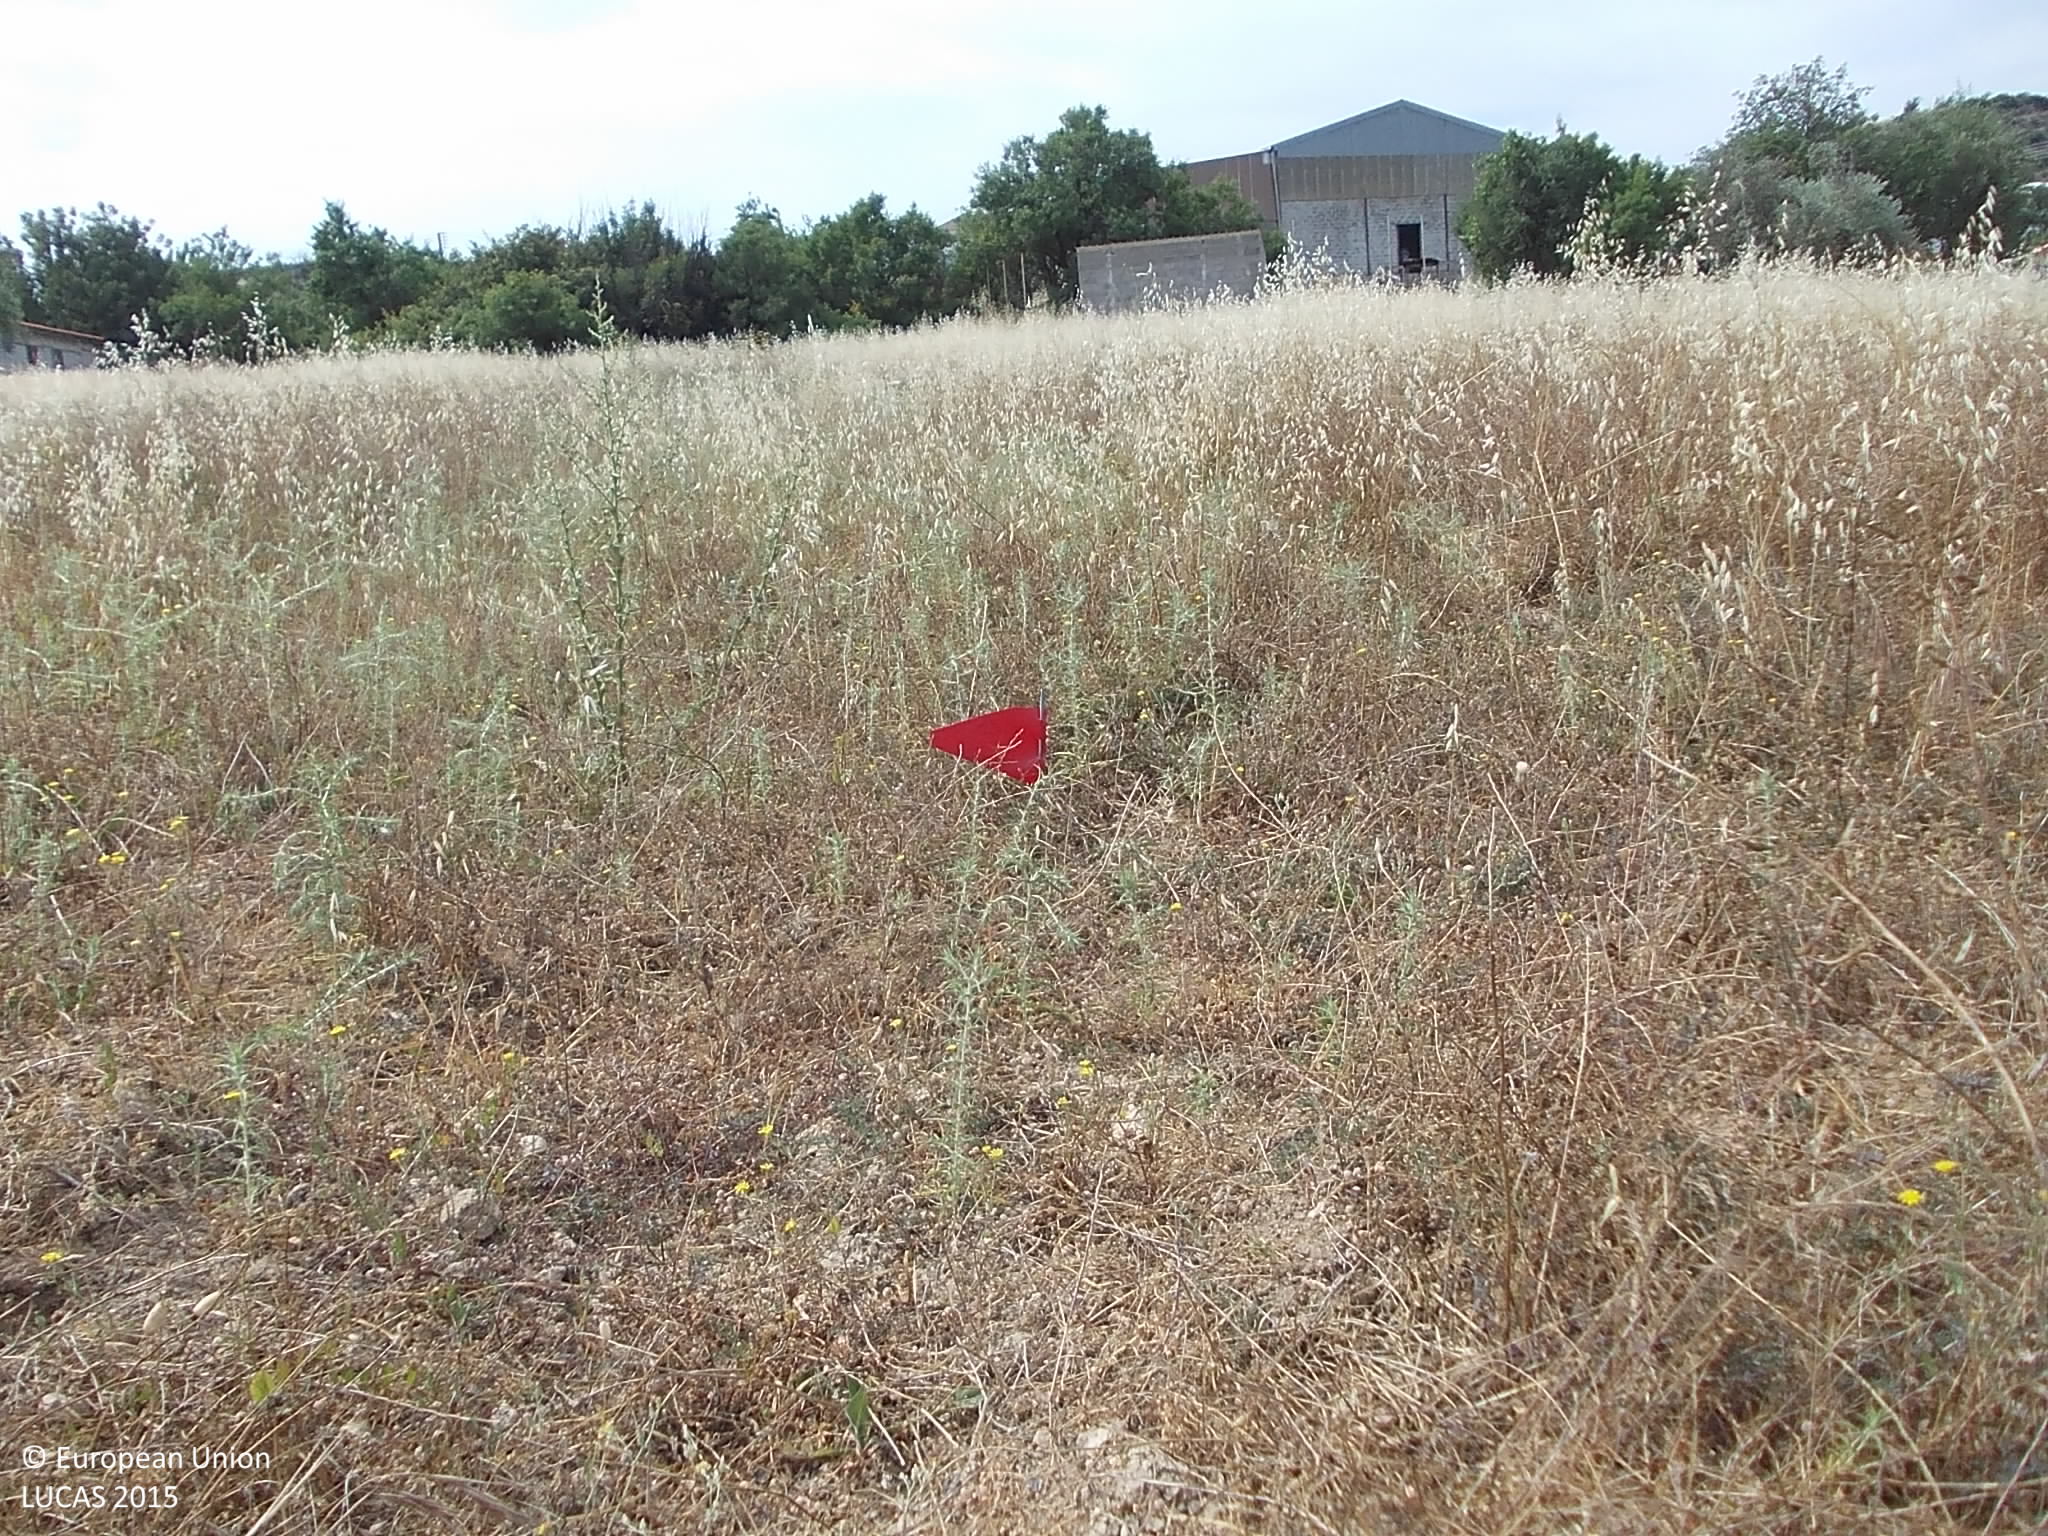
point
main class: Grassland
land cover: Spontaneously vegetated surfaces
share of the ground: > 75 %
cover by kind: herbaceous plants 90 %, unconsolidated bare surface 10 %
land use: Fallow land
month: May
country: CY
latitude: 34.7597
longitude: 32.9874
